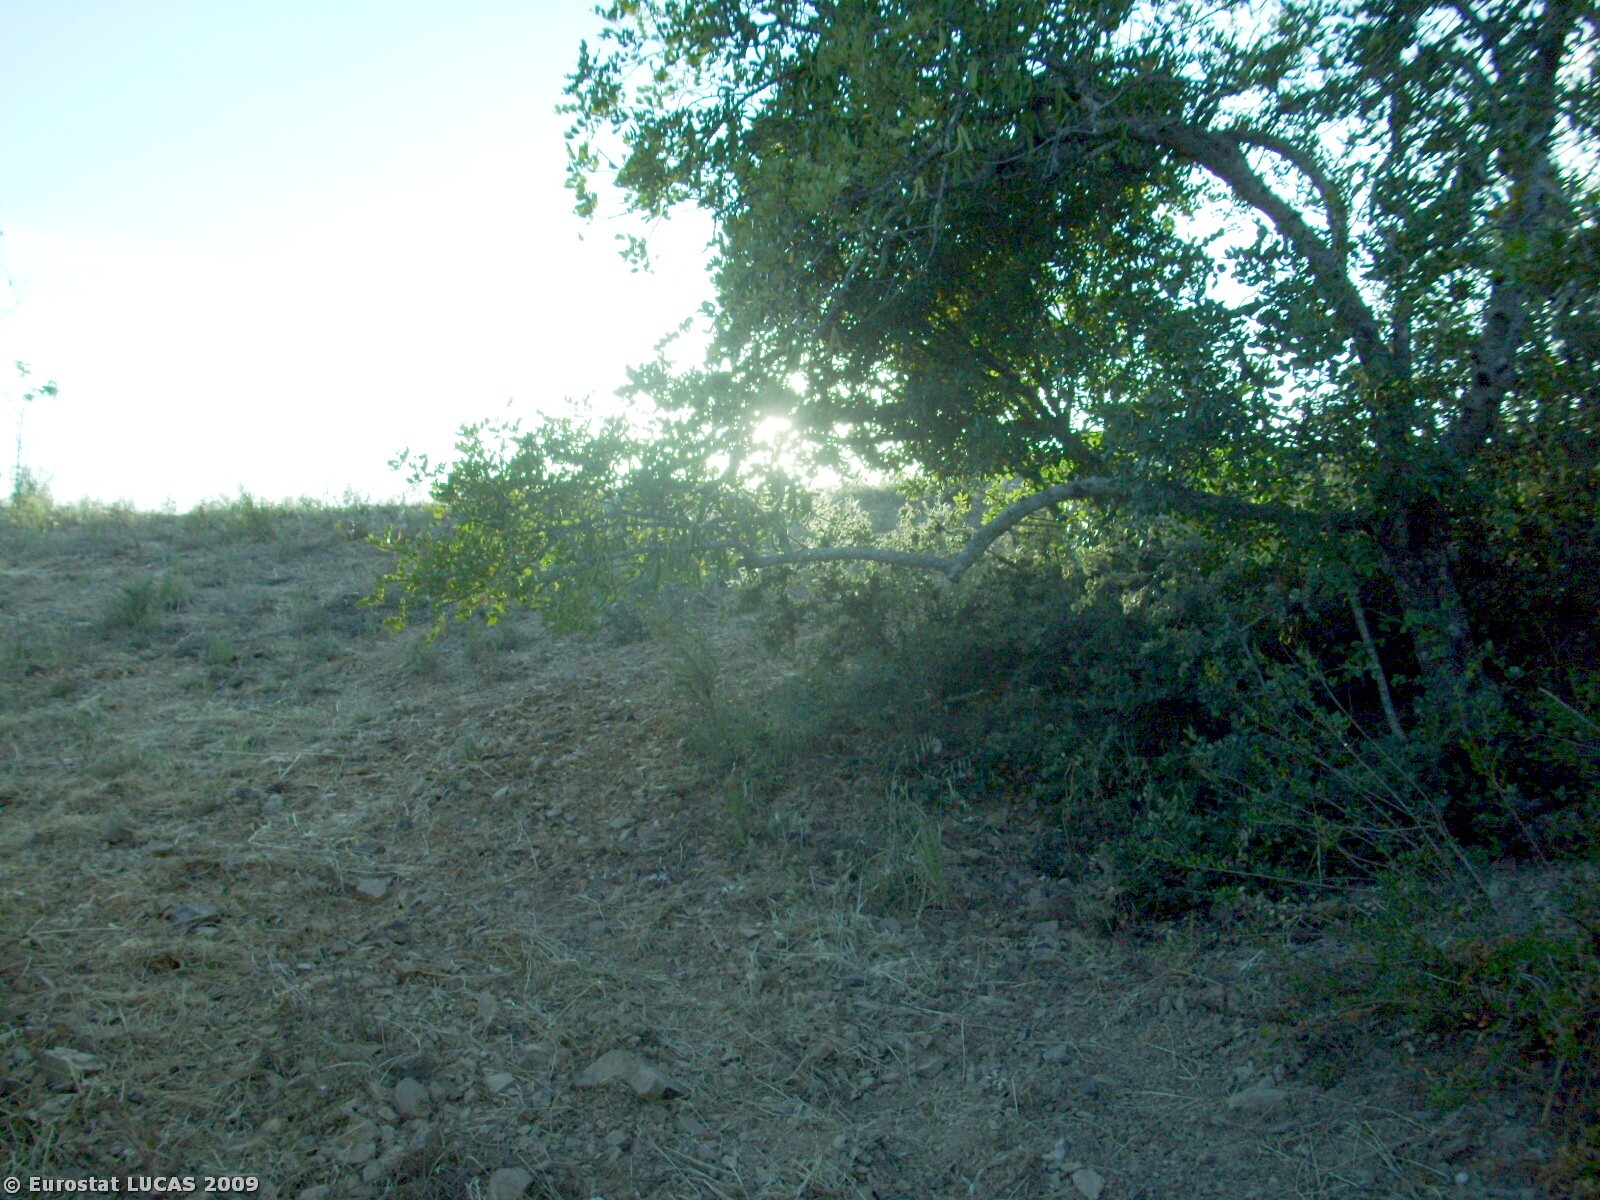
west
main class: Shrubland
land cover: Shrubland without tree cover
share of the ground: > 75 %
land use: Unused
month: May
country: PT
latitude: 37.2566
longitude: -8.1836
